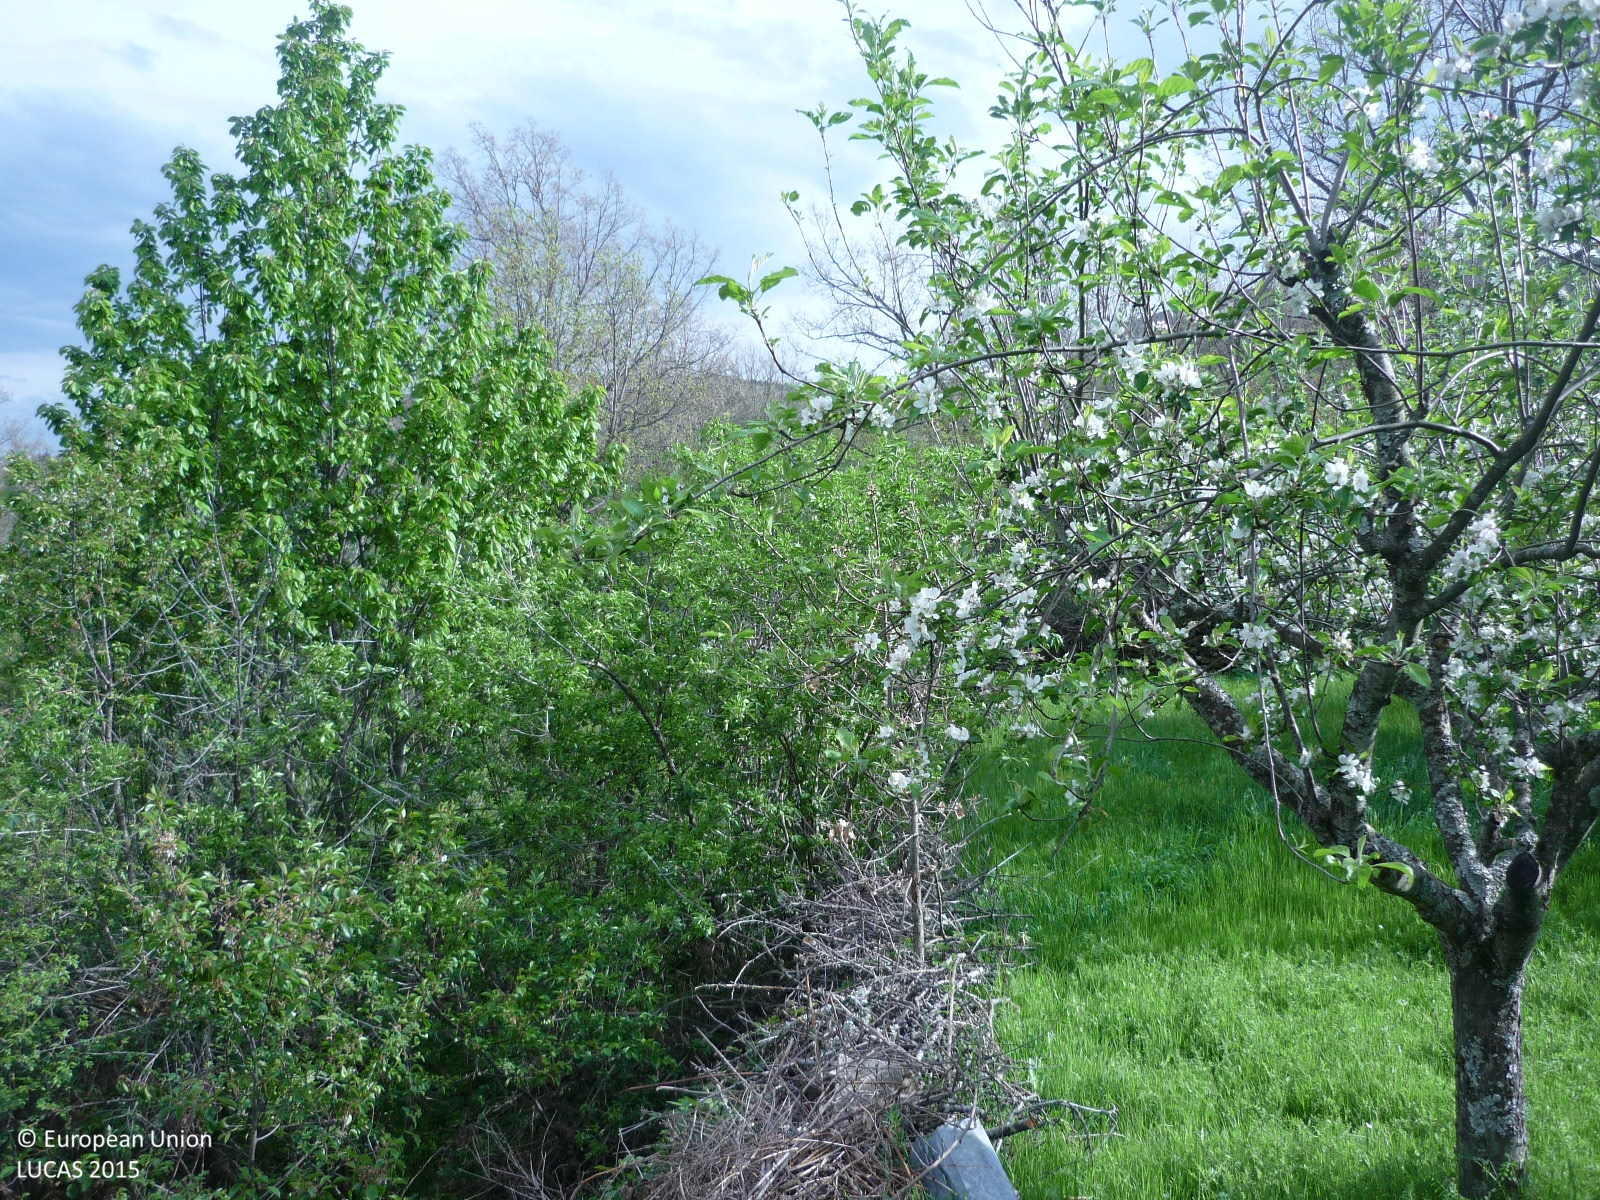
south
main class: Cropland
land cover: Apple fruit
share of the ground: 25 - 50 %
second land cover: Grassland without tree/shrub cover
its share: > 75 %
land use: Agriculture (excluding fallow land and kitchen gardens)
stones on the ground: < 10 %
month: May
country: ES
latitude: 41.0878
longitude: -3.6277
